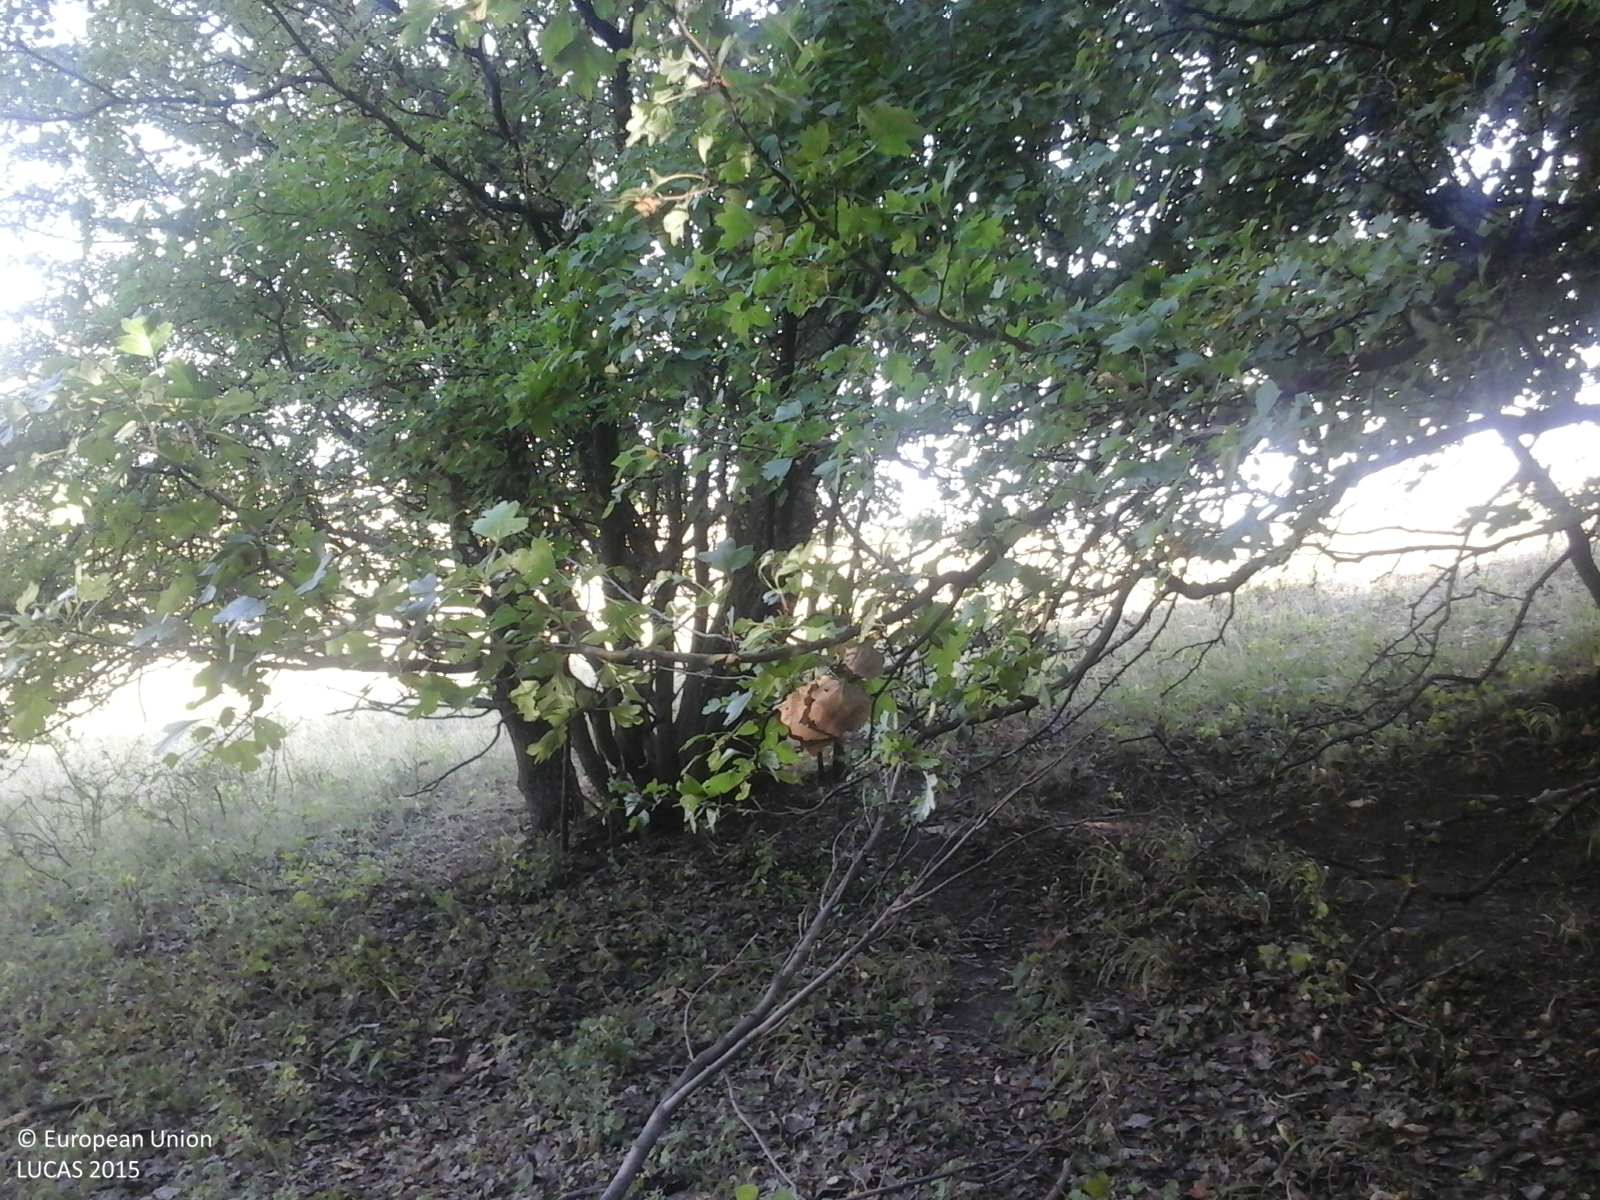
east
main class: Woodland
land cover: Broadleaved woodland
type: acidophilous oak and oak-birch forest
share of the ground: > 75 %
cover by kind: broadleaved forest trees 100 %
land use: Forestry
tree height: > 5 m
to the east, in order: Broadleaved woodland; Grassland without tree/shrub cover
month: July
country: RO
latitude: 46.3932
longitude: 27.2291
